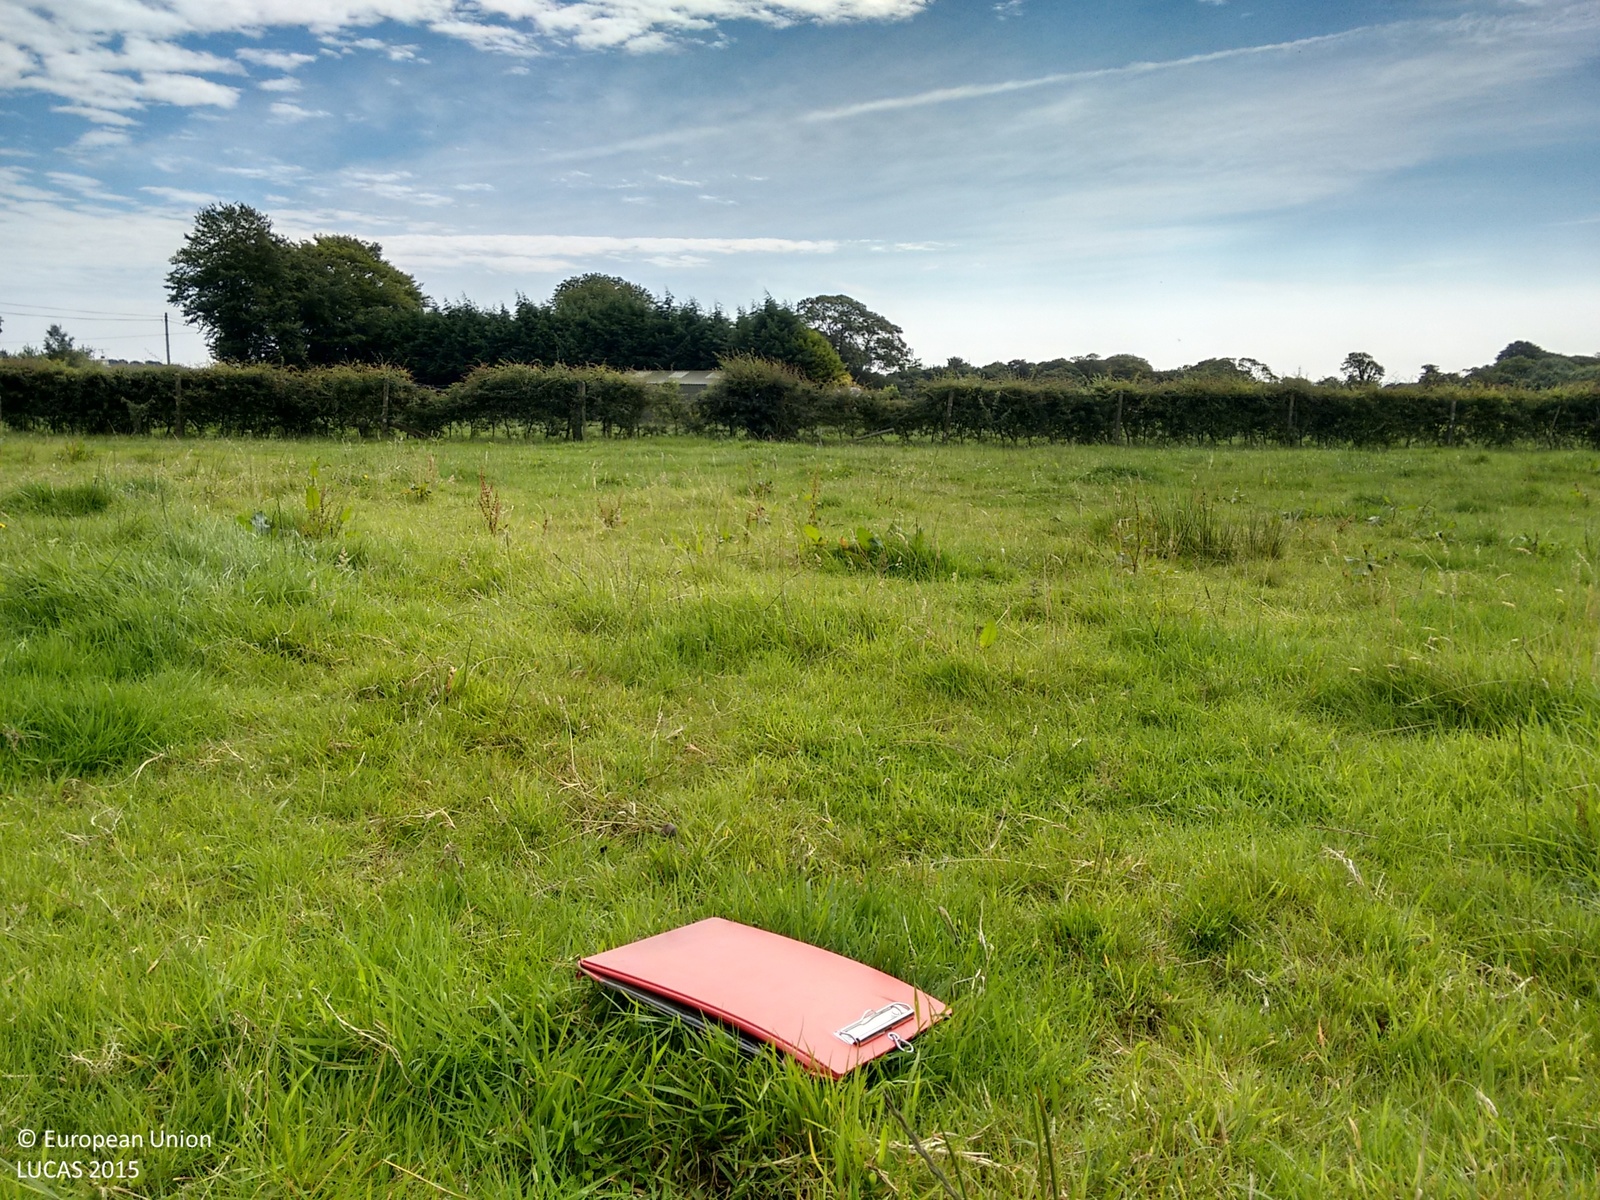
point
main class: Grassland
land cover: Grassland without tree/shrub cover
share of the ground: > 75 %
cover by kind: herbaceous plants 100 %
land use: Agriculture (excluding fallow land and kitchen gardens)
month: August
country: IE
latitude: 53.0295
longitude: -7.5306
